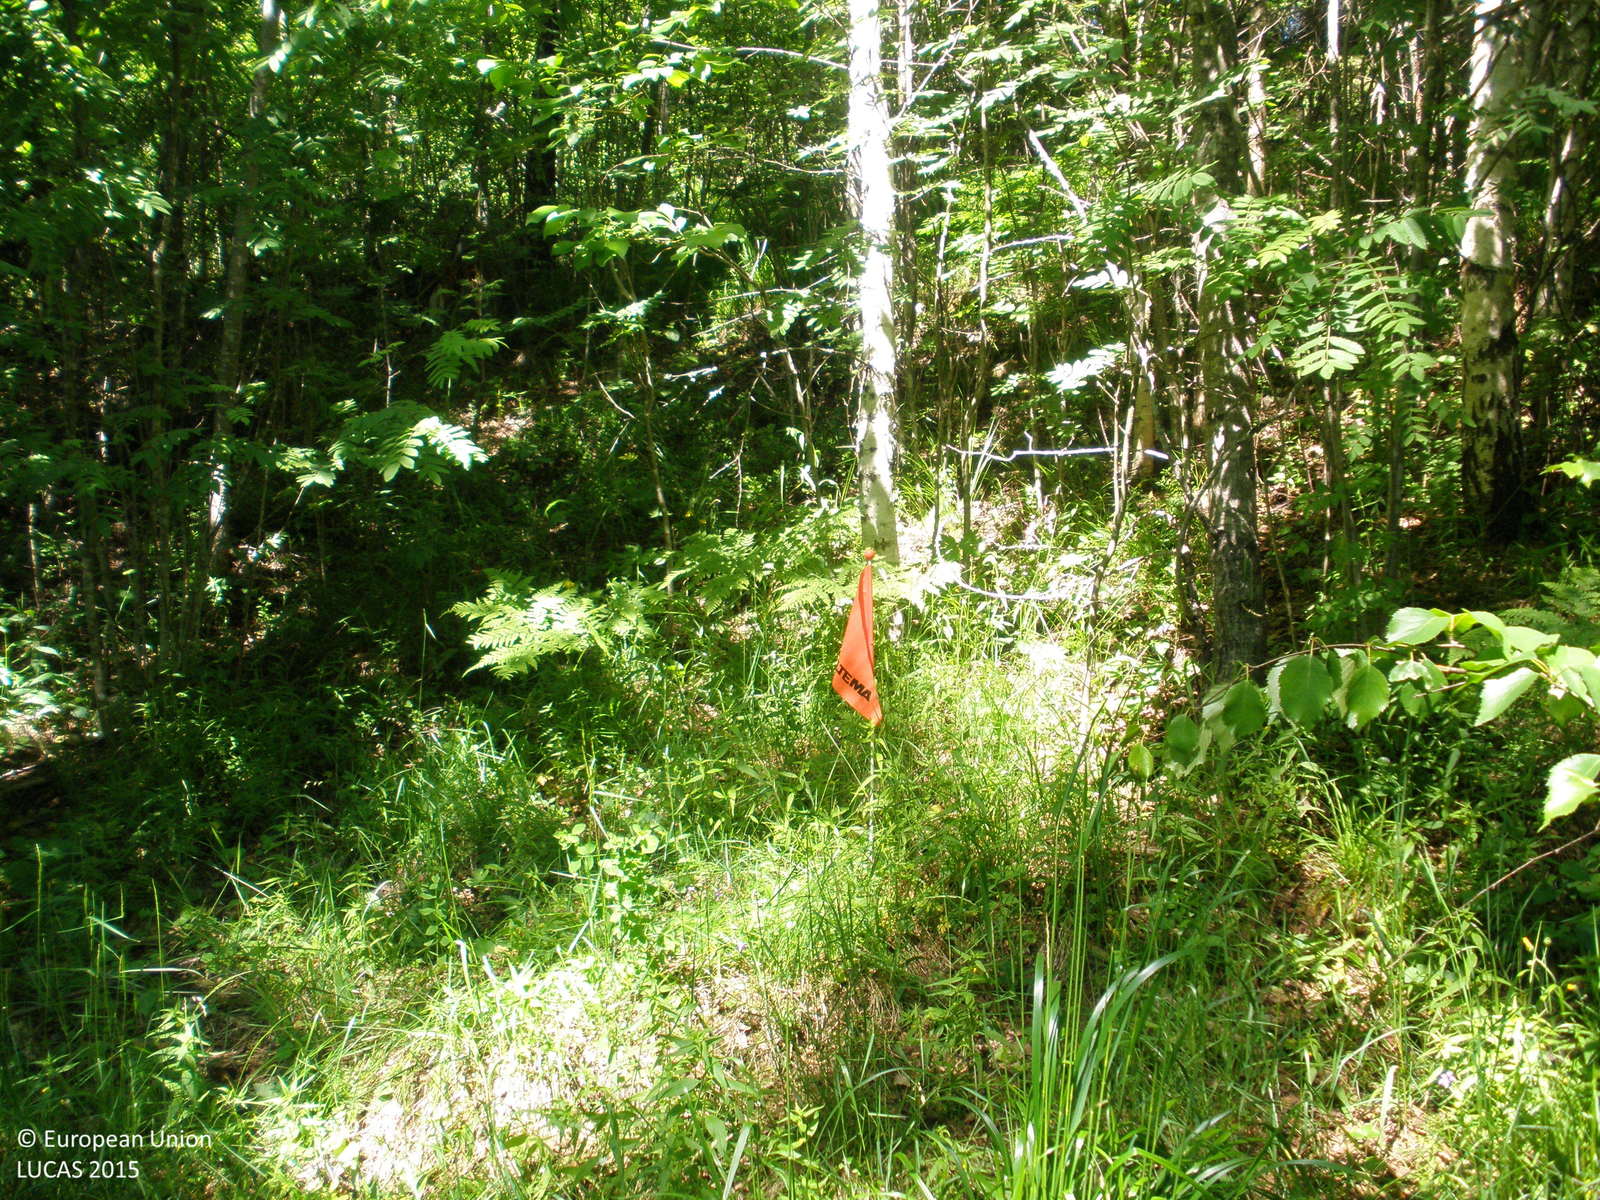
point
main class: Woodland
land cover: Broadleaved woodland
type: non-riverine alder, birch or aspen forest
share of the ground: > 75 %
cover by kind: broadleaved forest trees 85 %, herbaceous plants 15 %
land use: Forestry
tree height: > 5 m
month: July
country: FI
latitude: 61.0401
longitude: 23.7697
